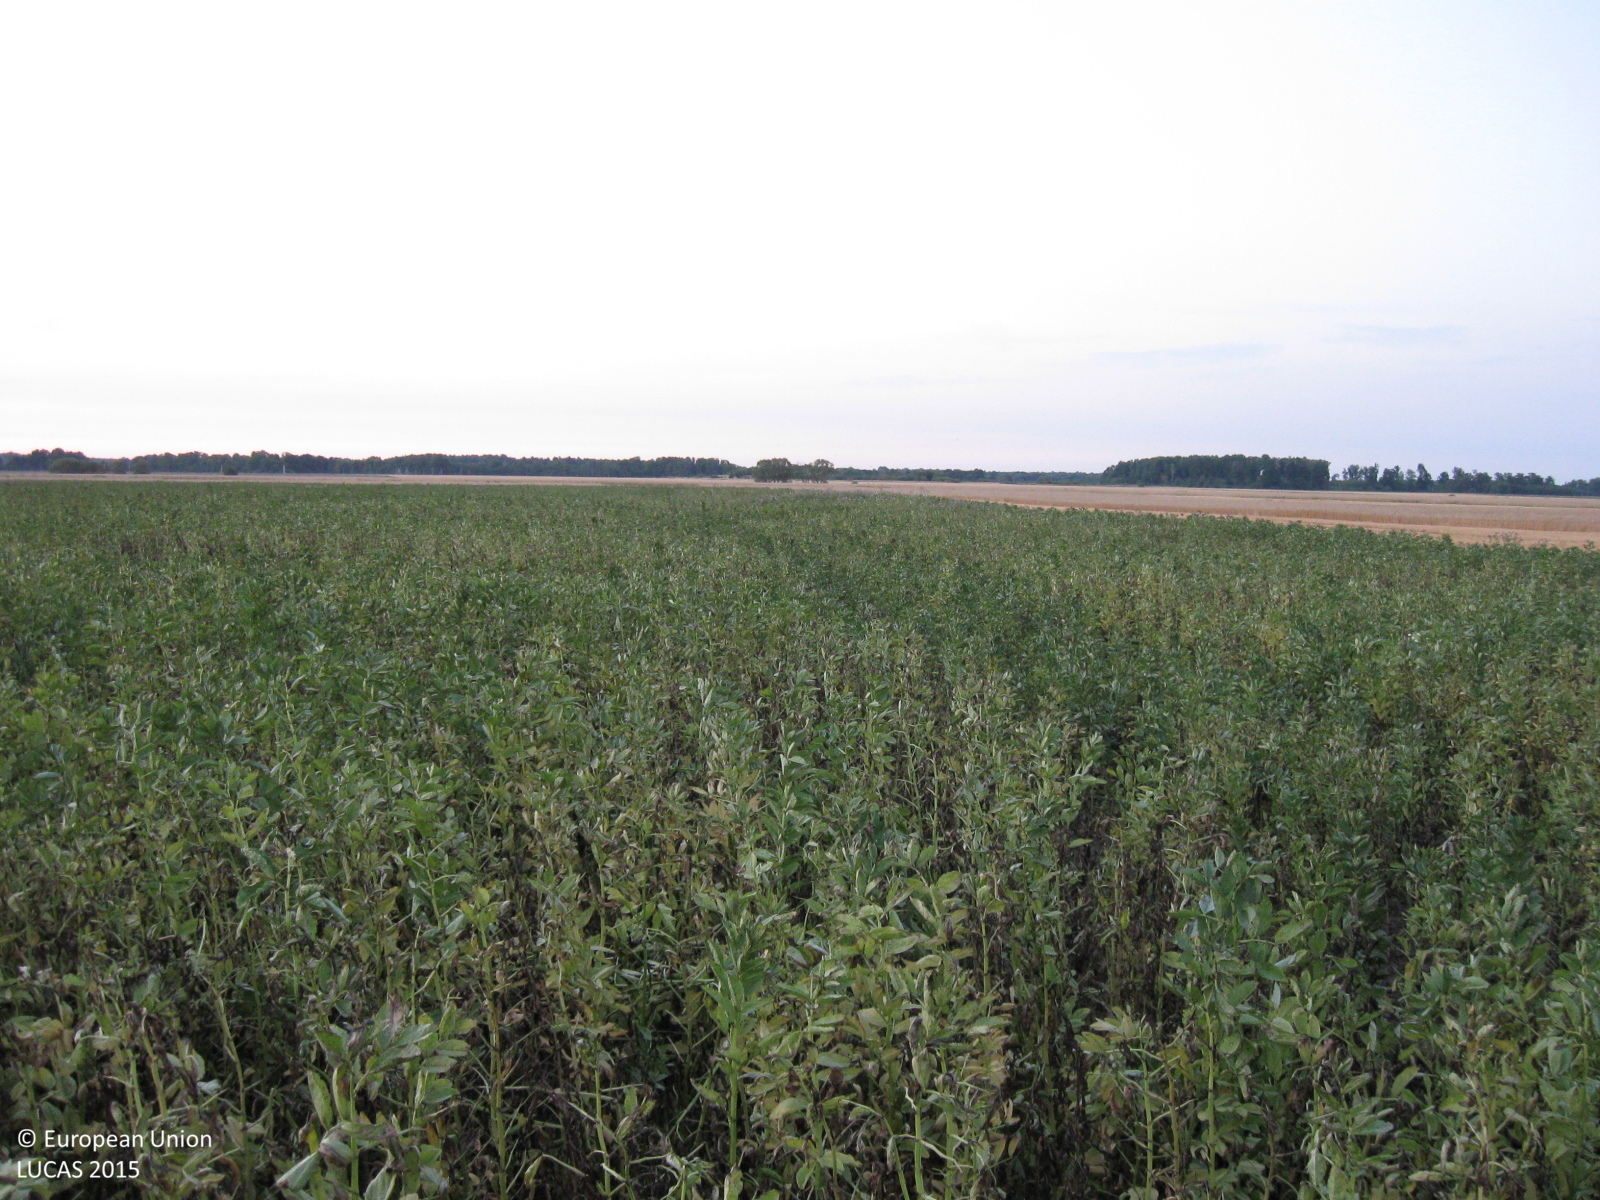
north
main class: Cropland
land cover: Dry pulses
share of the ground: > 75 %
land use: Agriculture (excluding fallow land and kitchen gardens)
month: August
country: LT
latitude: 55.1513
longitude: 22.8893
